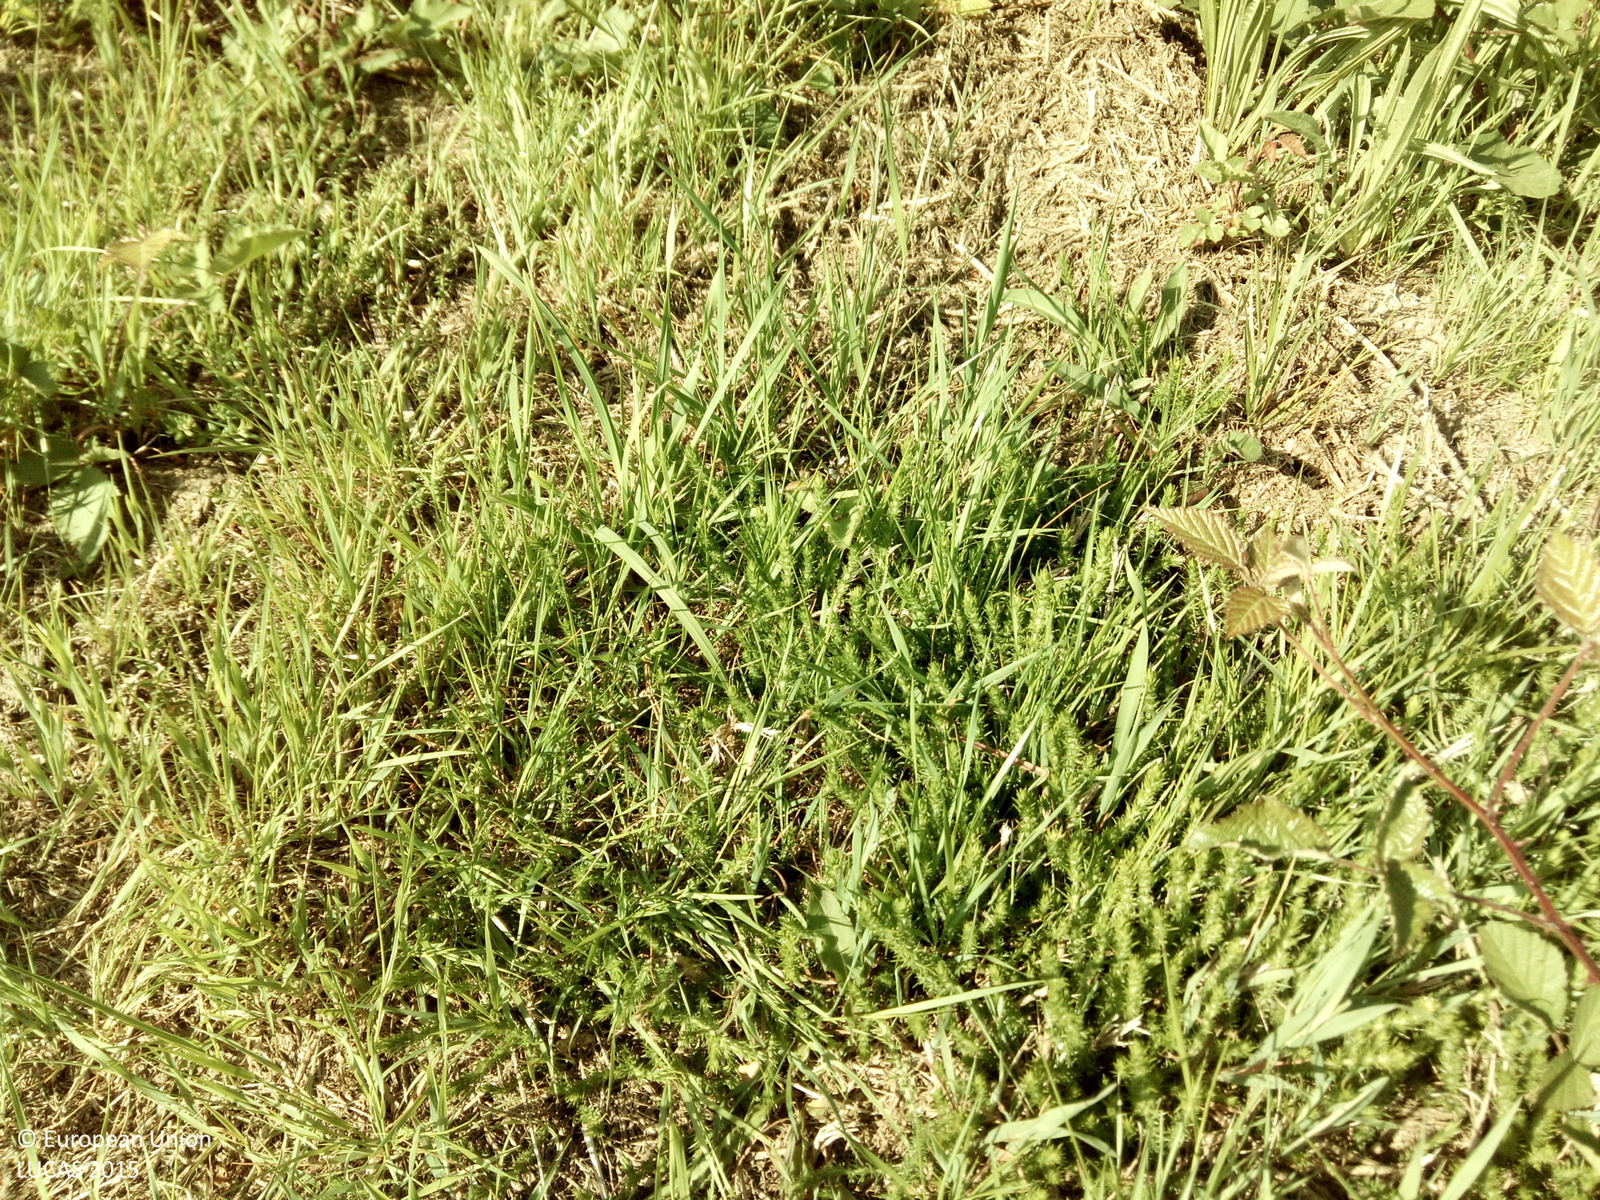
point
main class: Grassland
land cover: Grassland without tree/shrub cover
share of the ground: > 75 %
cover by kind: herbaceous plants 100 %
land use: Abandoned areas
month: May
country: ES
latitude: 42.6930
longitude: -8.4702
